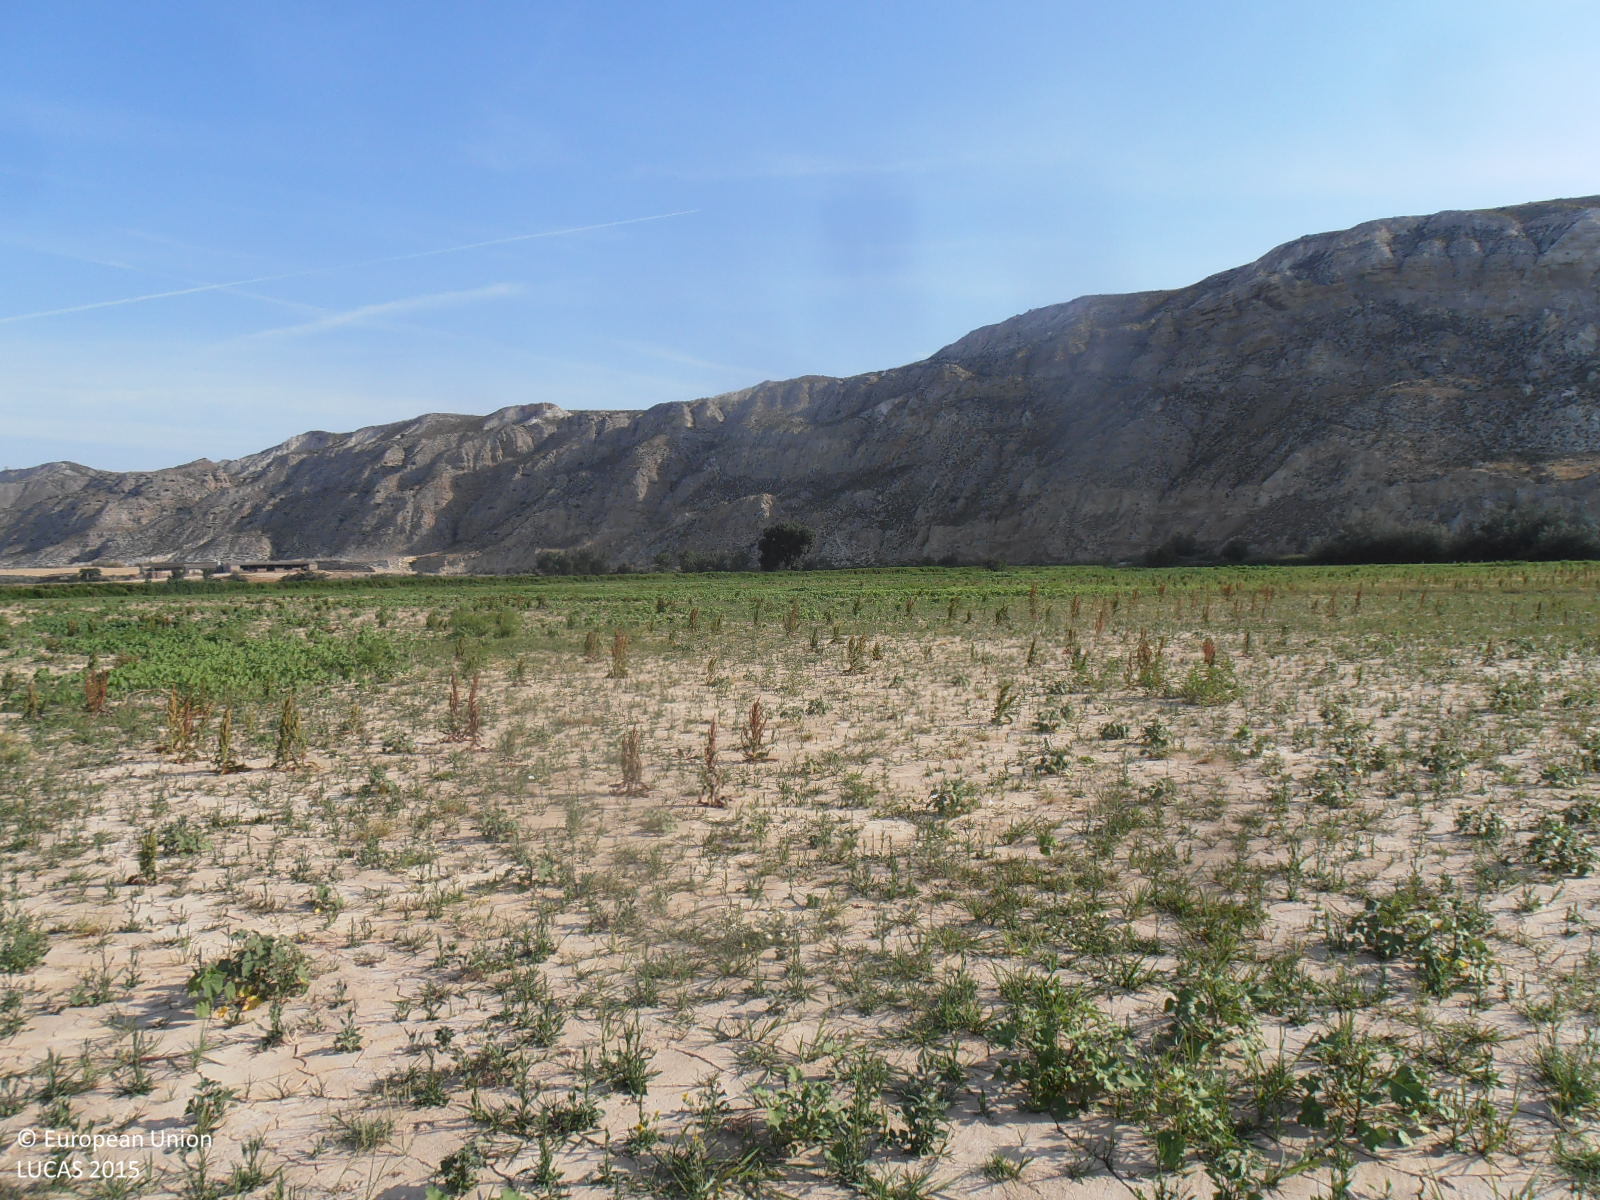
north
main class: Grassland
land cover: Spontaneously vegetated surfaces
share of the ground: 25 - 50 %
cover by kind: unconsolidated bare surface 60 %, herbaceous plants 40 %
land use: Abandoned areas
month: June
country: ES
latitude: 41.7432
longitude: -1.0020
